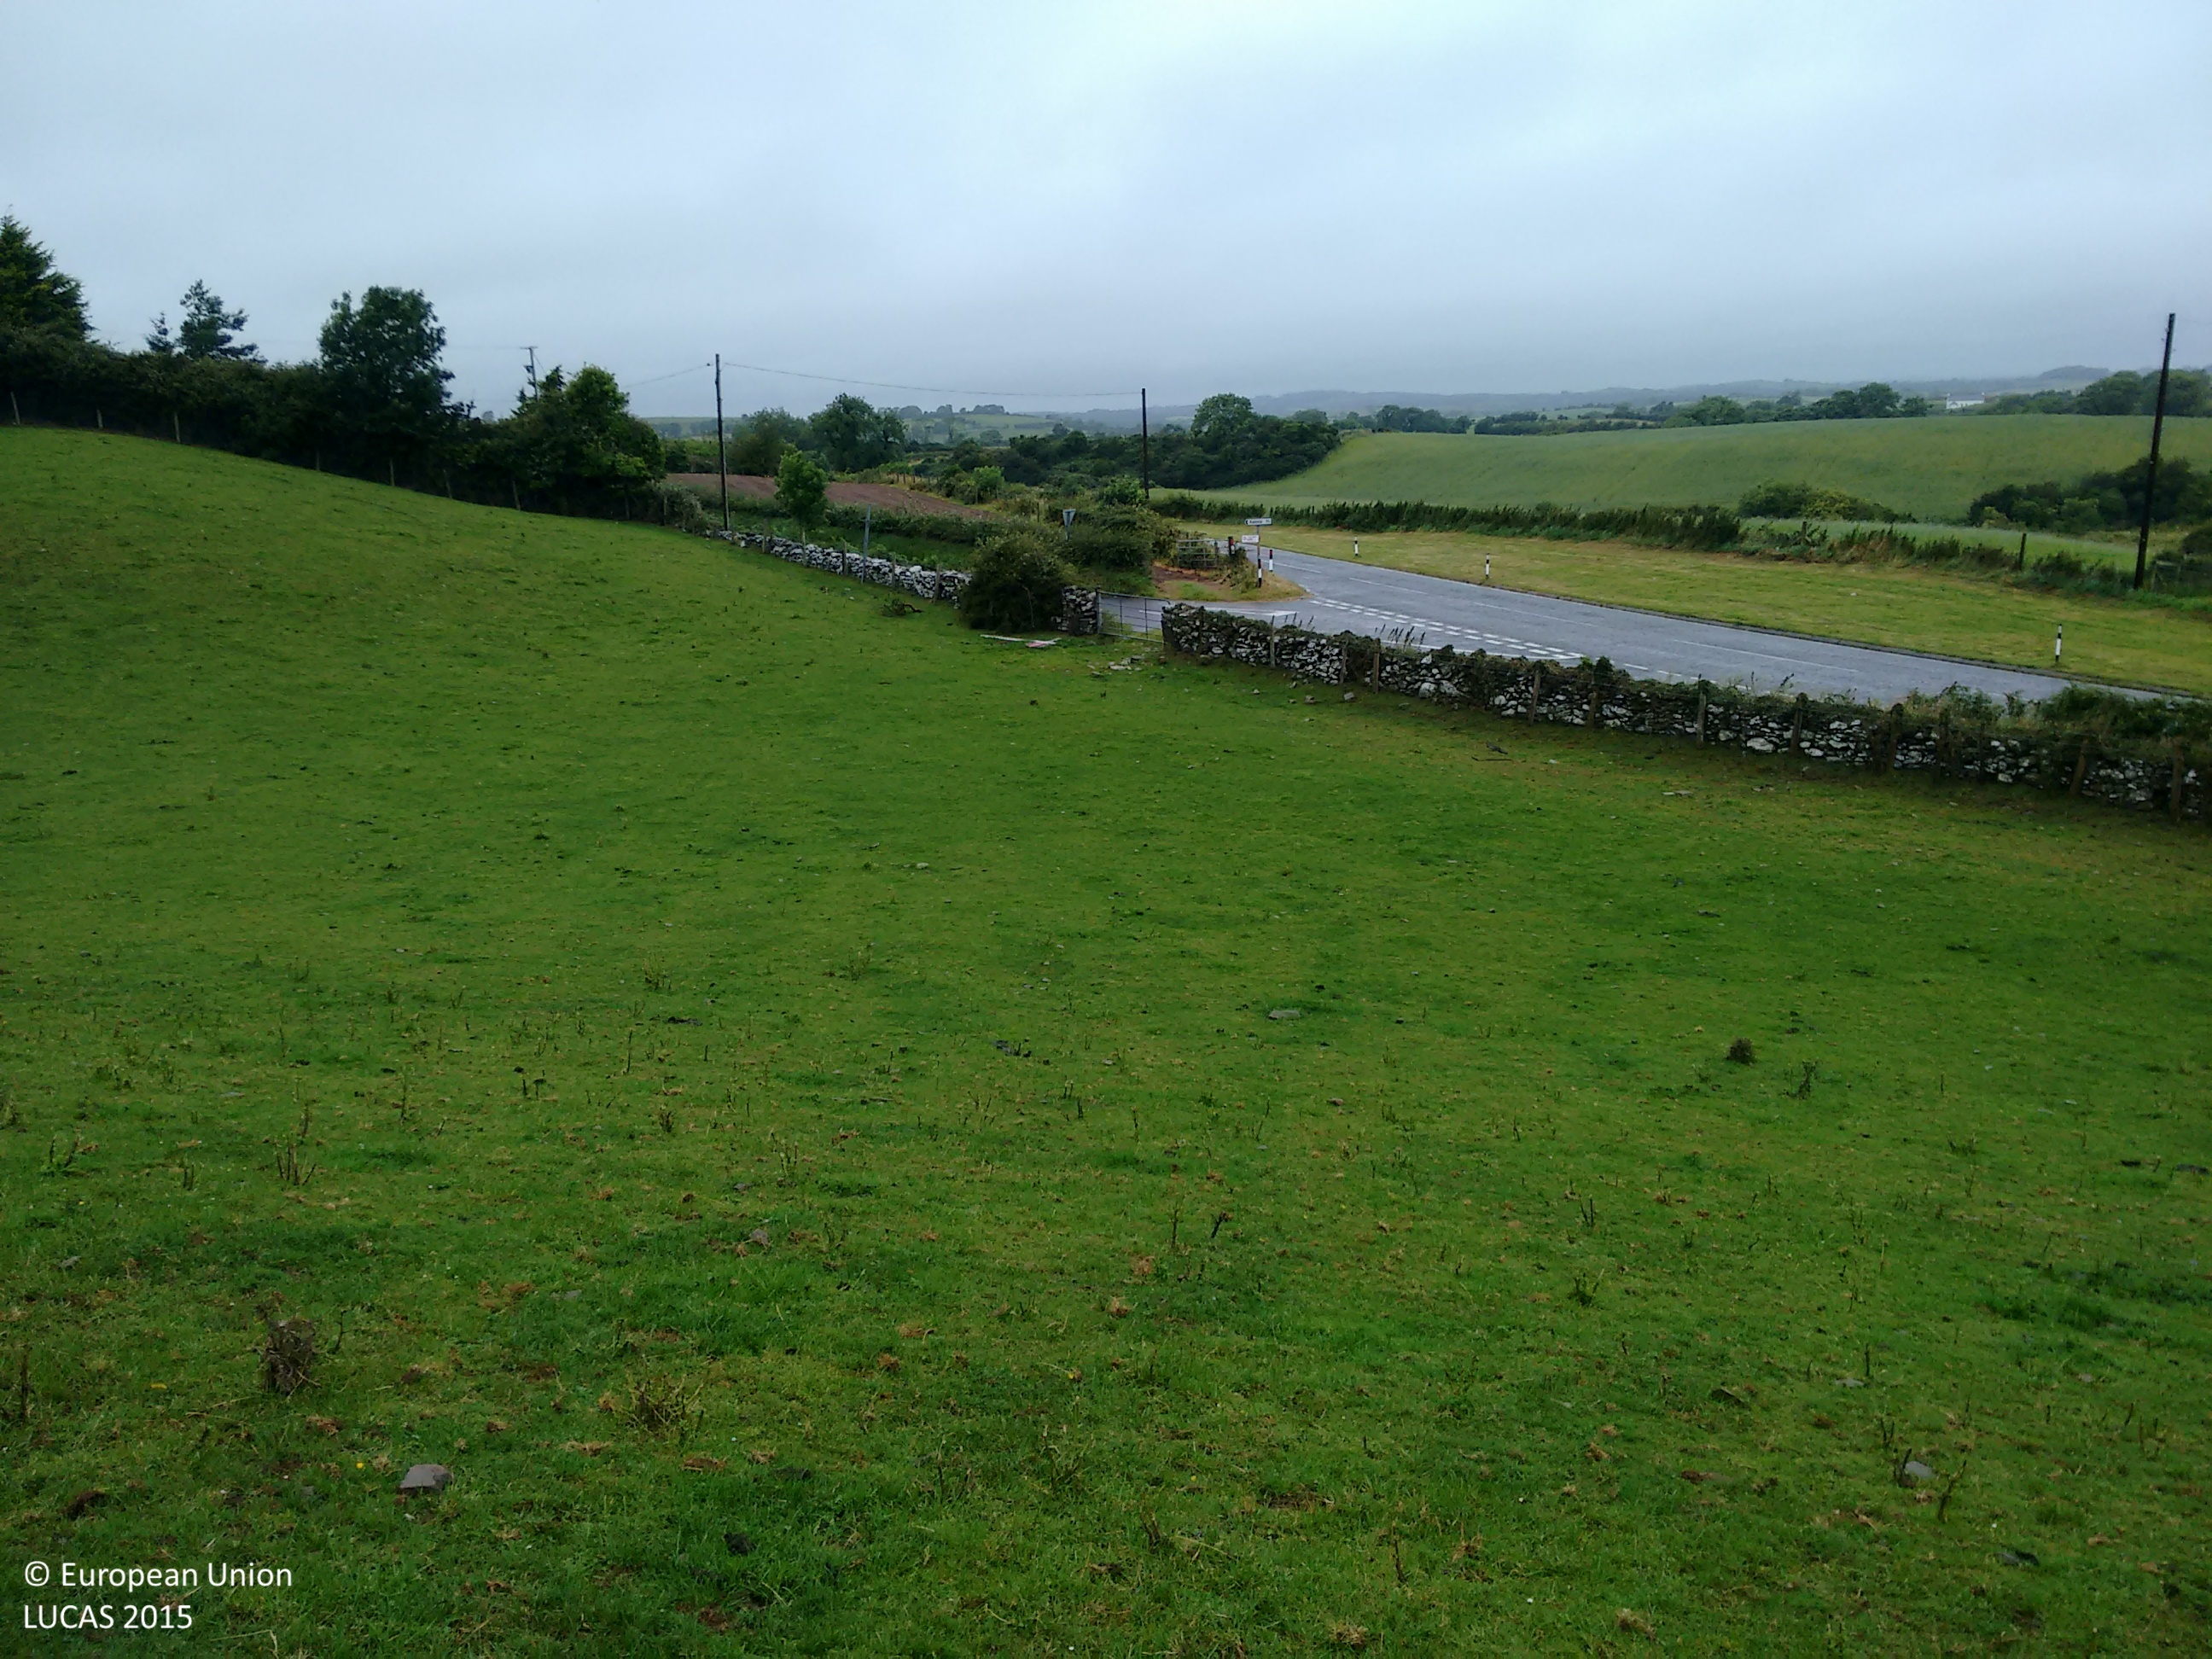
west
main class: Grassland
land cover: Grassland without tree/shrub cover
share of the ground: > 75 %
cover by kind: herbaceous plants 100 %
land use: Agriculture (excluding fallow land and kitchen gardens)
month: August
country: GB
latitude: 54.3590
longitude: -5.6272
